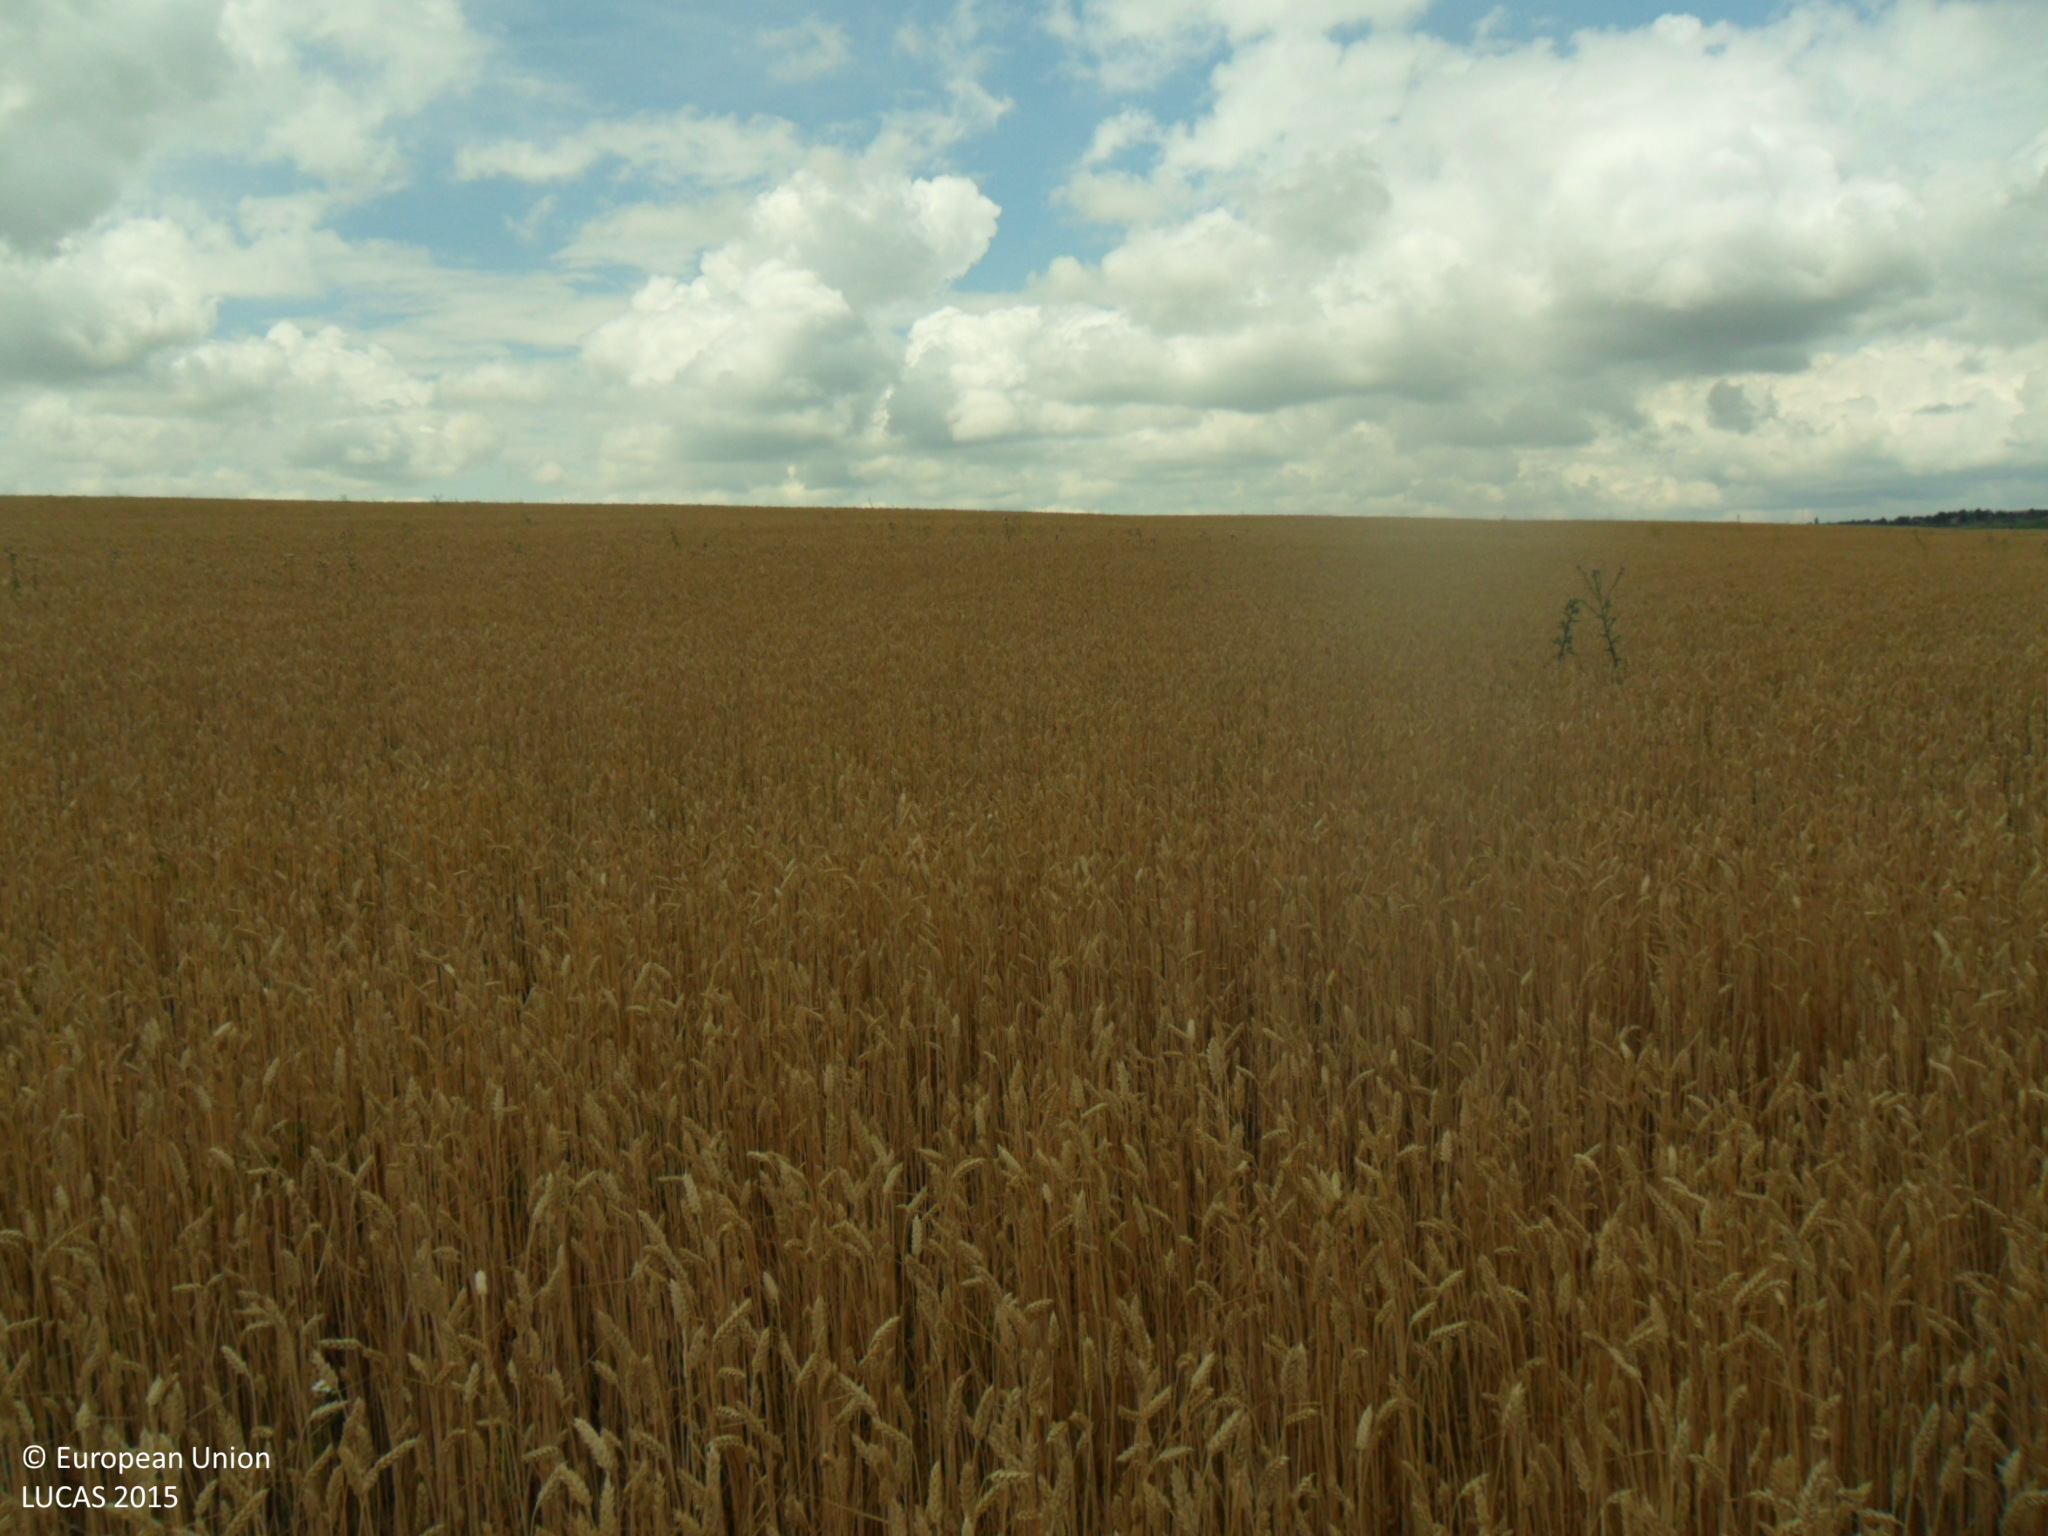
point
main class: Cropland
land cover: Common wheat
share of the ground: > 75 %
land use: Agriculture (excluding fallow land and kitchen gardens)
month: July
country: BG
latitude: 43.4430
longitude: 27.2613
